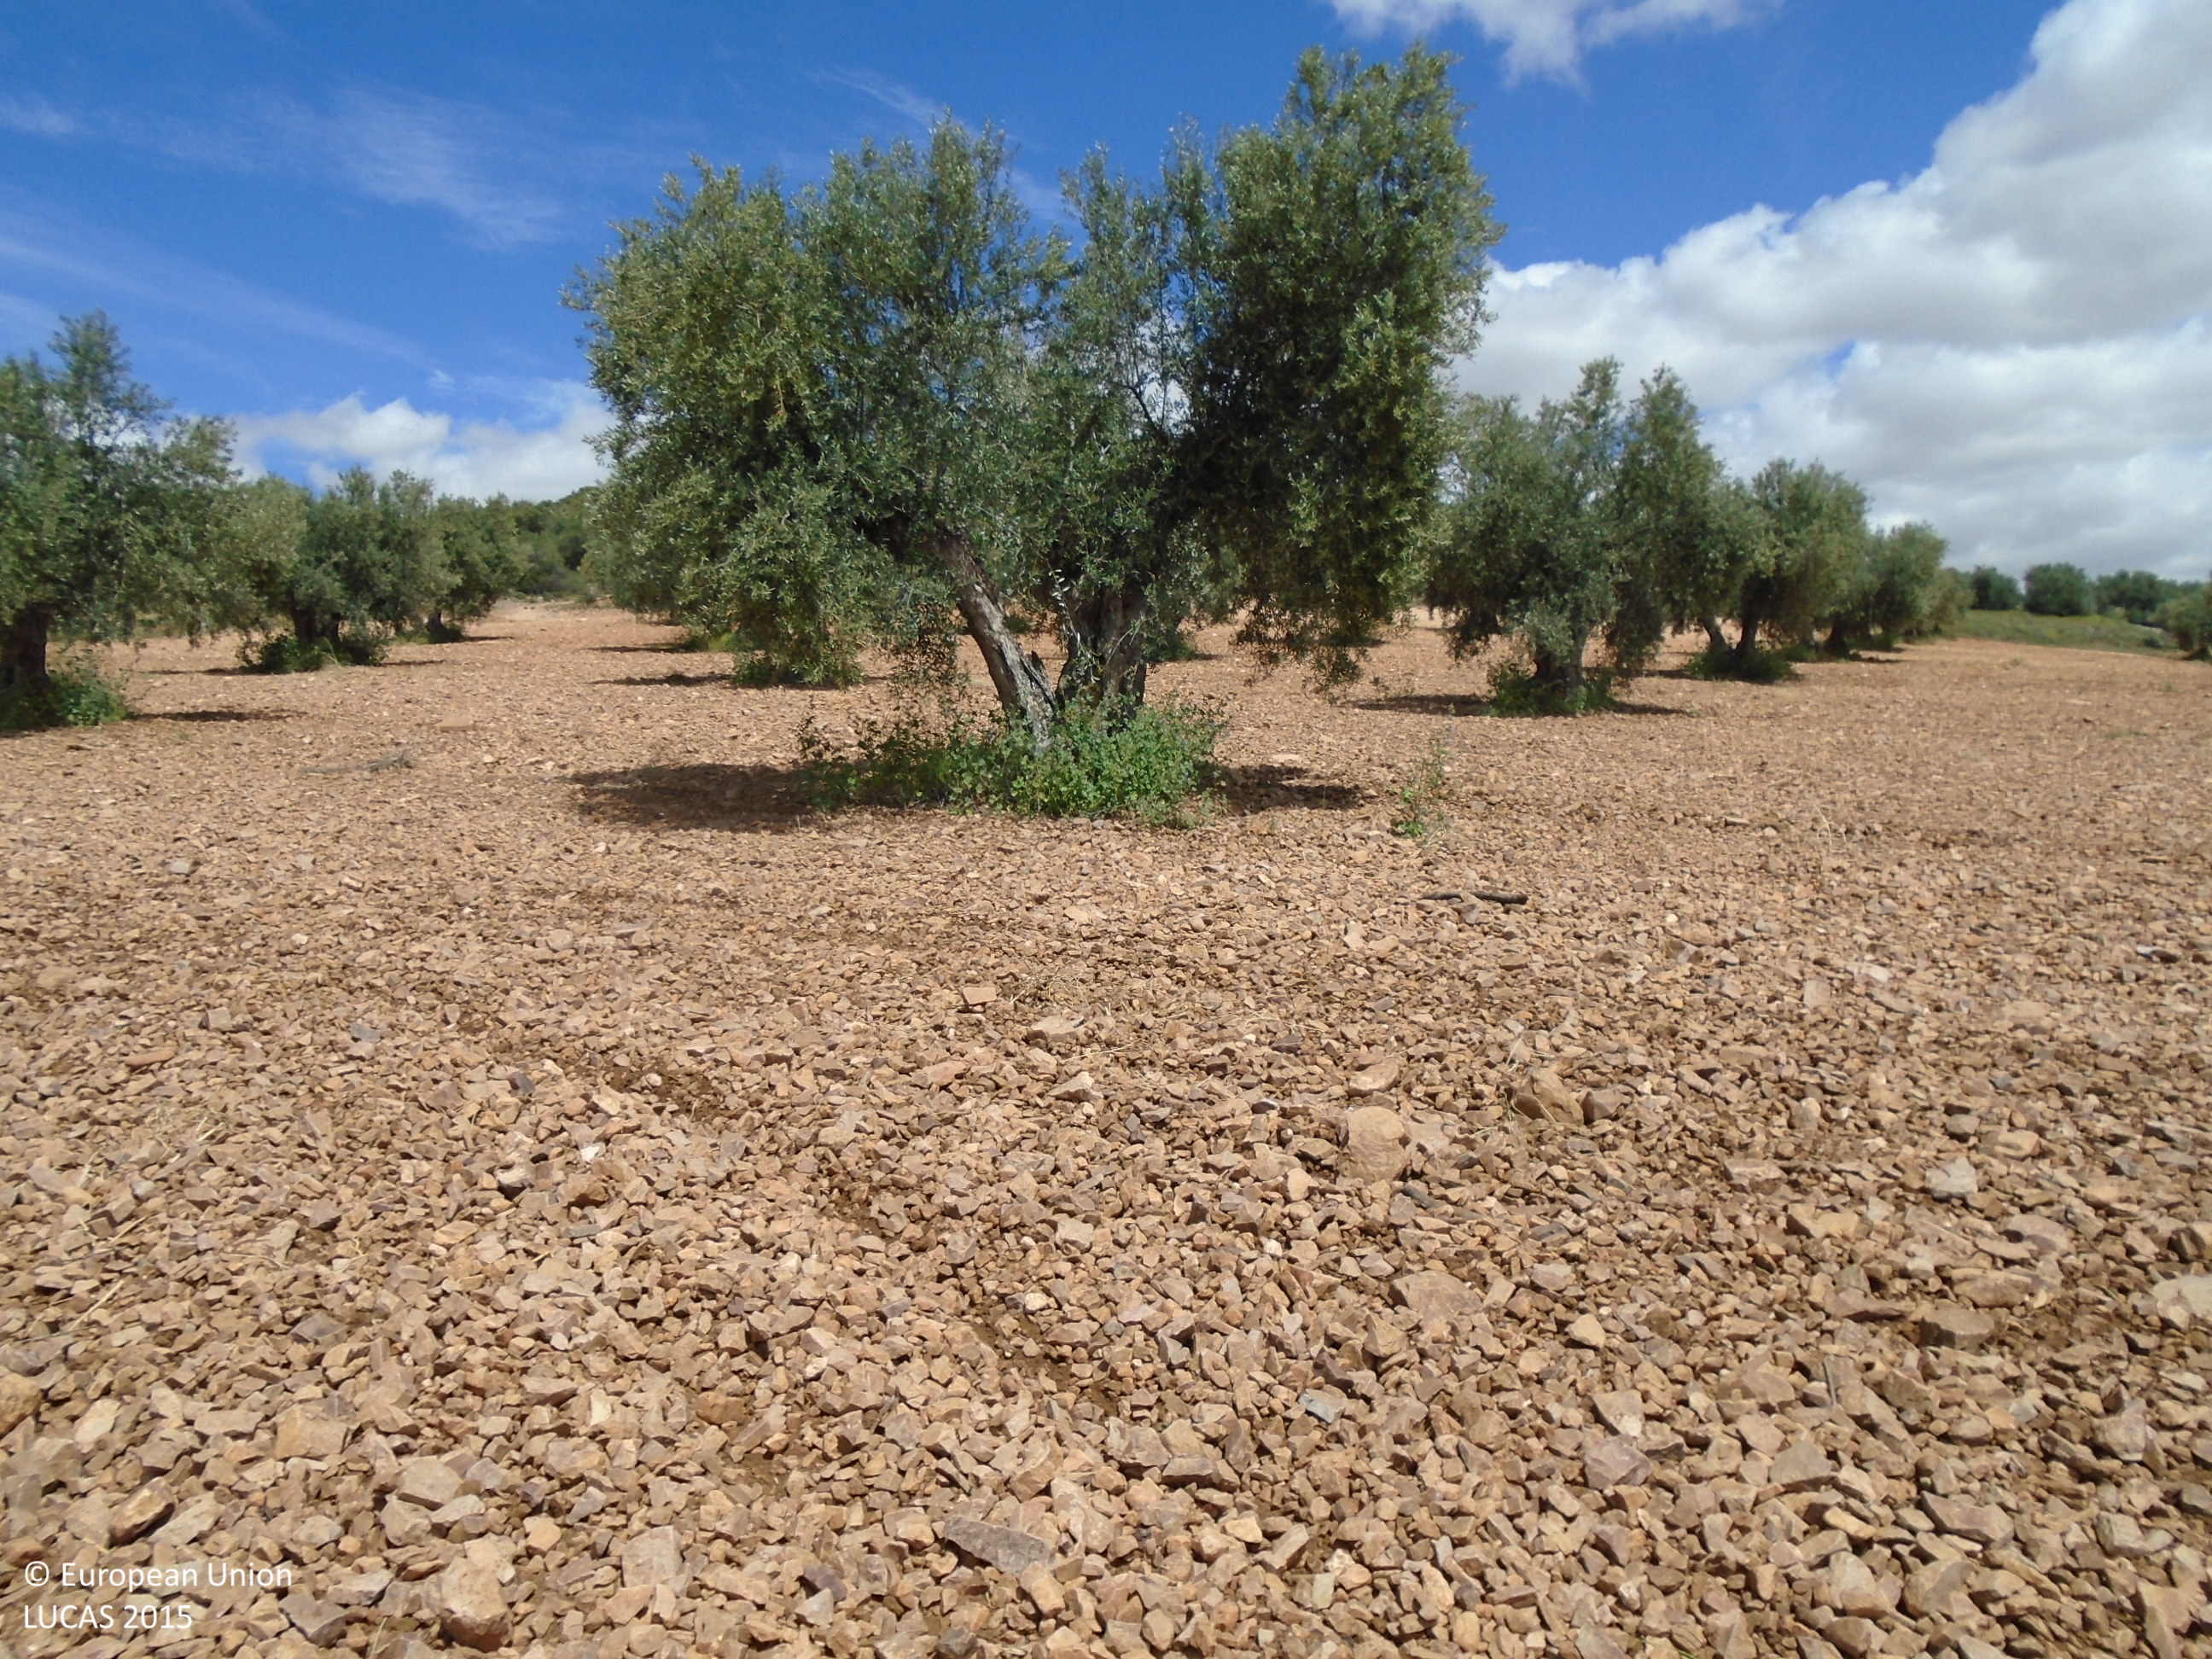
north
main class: Cropland
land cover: Olive groves
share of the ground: 10 - 25 %
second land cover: Other bare soil
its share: > 75 %
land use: Agriculture (excluding fallow land and kitchen gardens)
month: May
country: ES
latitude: 39.6288
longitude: -3.7164
